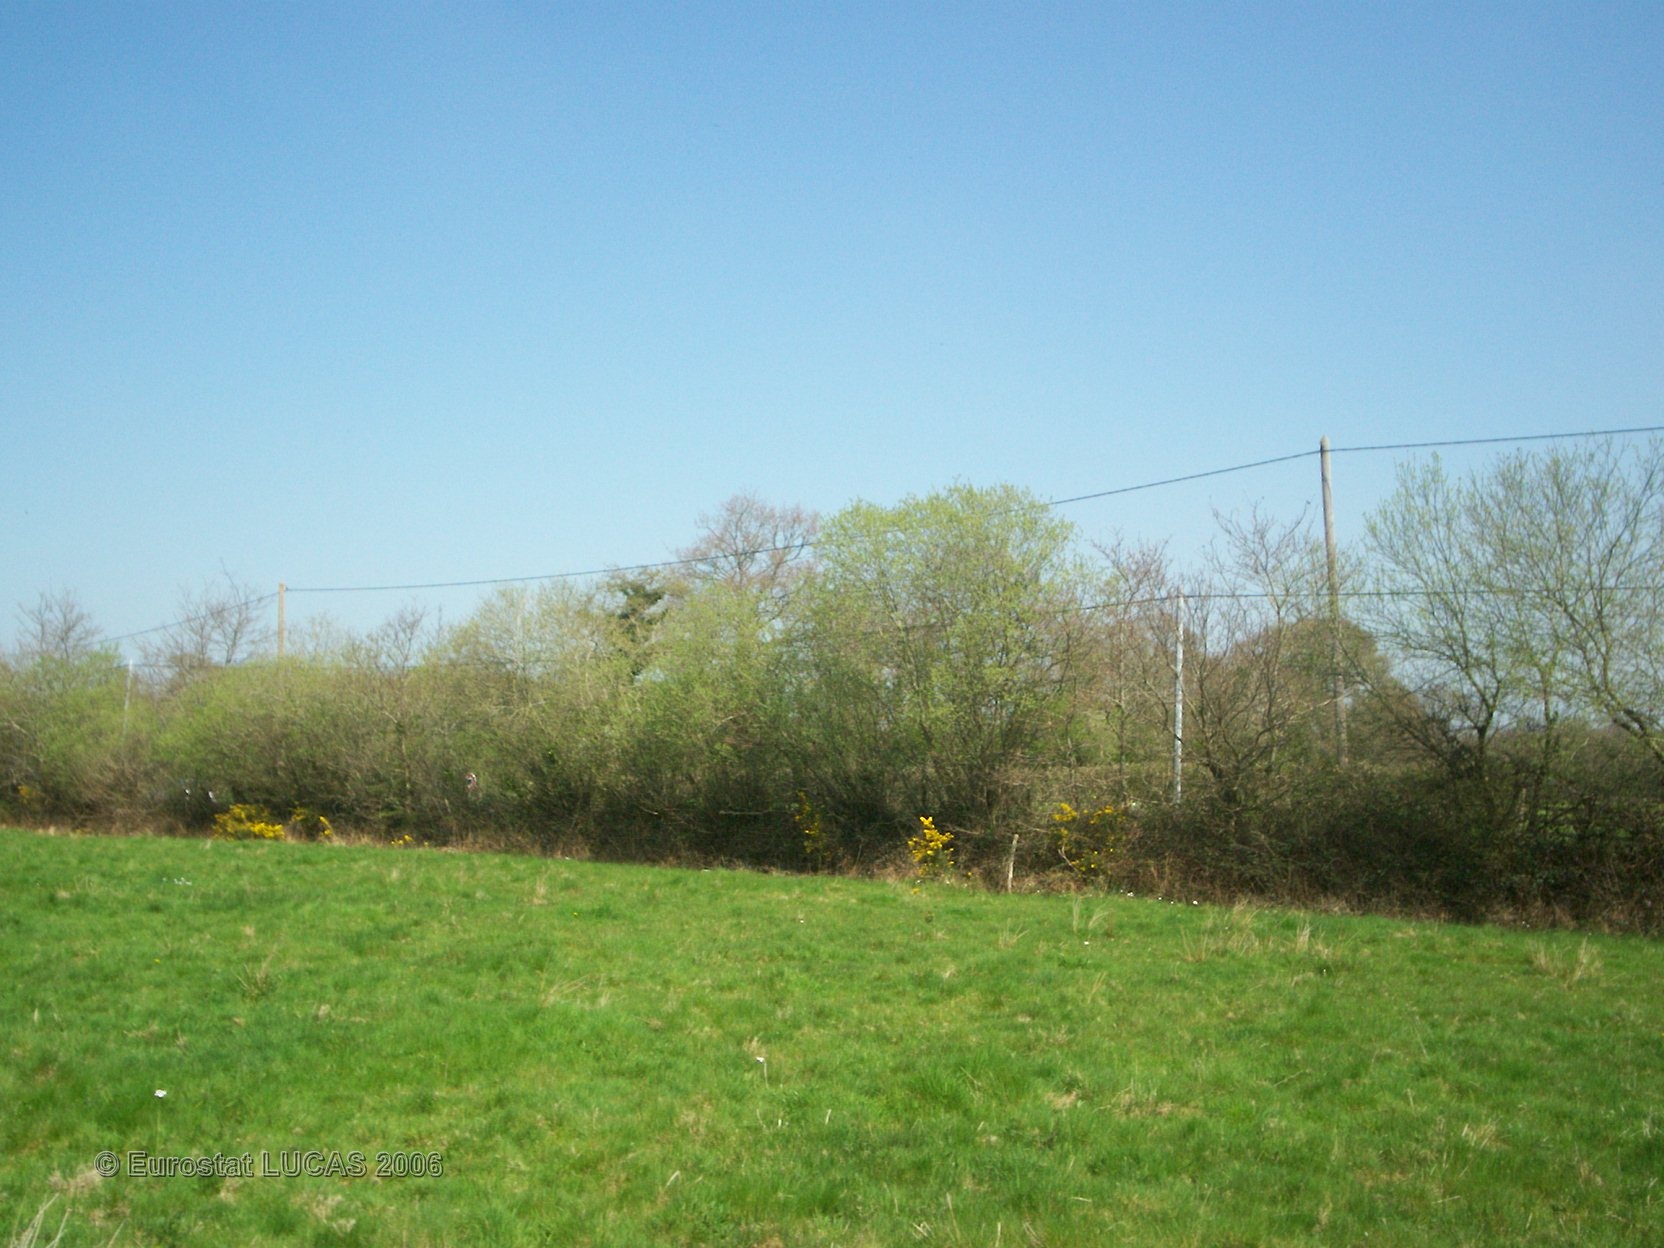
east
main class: Grassland
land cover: Grassland without tree/shrub cover
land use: Agriculture (excluding fallow land and kitchen gardens)
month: April
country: FR
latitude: 49.2052
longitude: -1.4541
